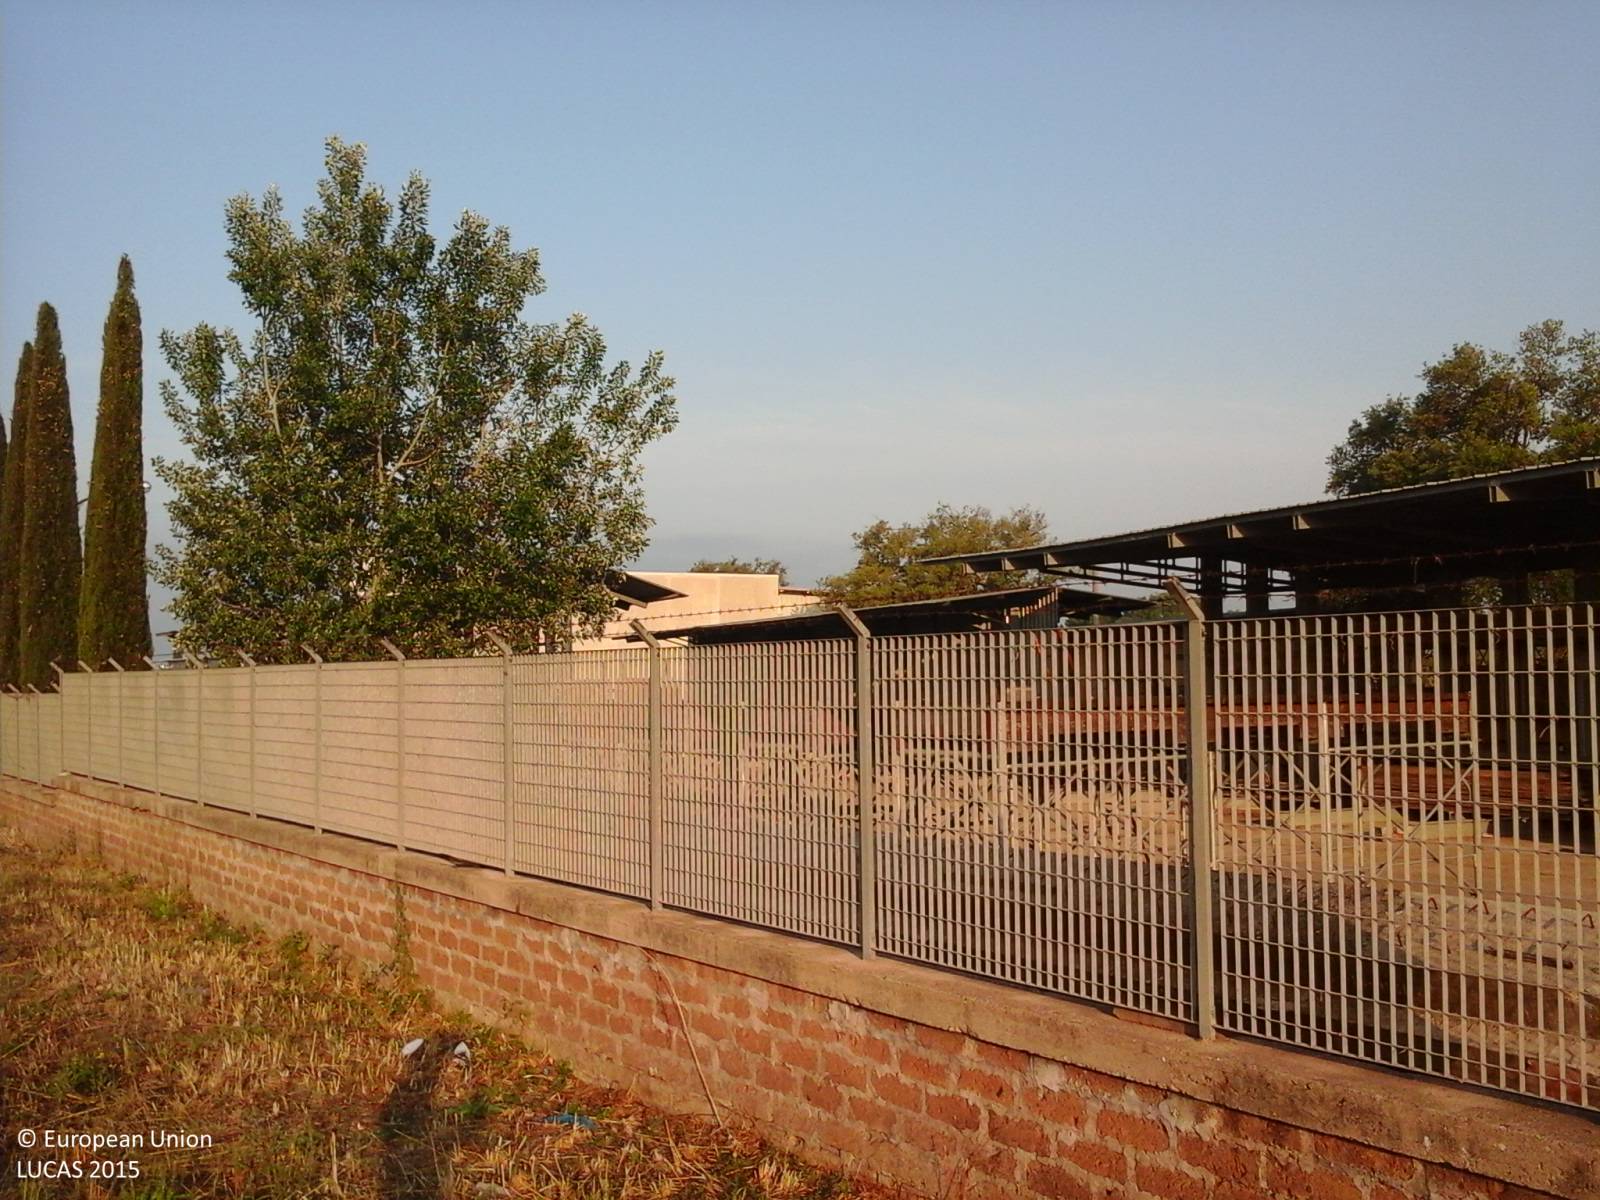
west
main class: Grassland
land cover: Grassland without tree/shrub cover
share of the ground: > 75 %
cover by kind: herbaceous plants 100 %
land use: Logistics and storage
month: June
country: IT
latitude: 42.4194
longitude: 11.9015
